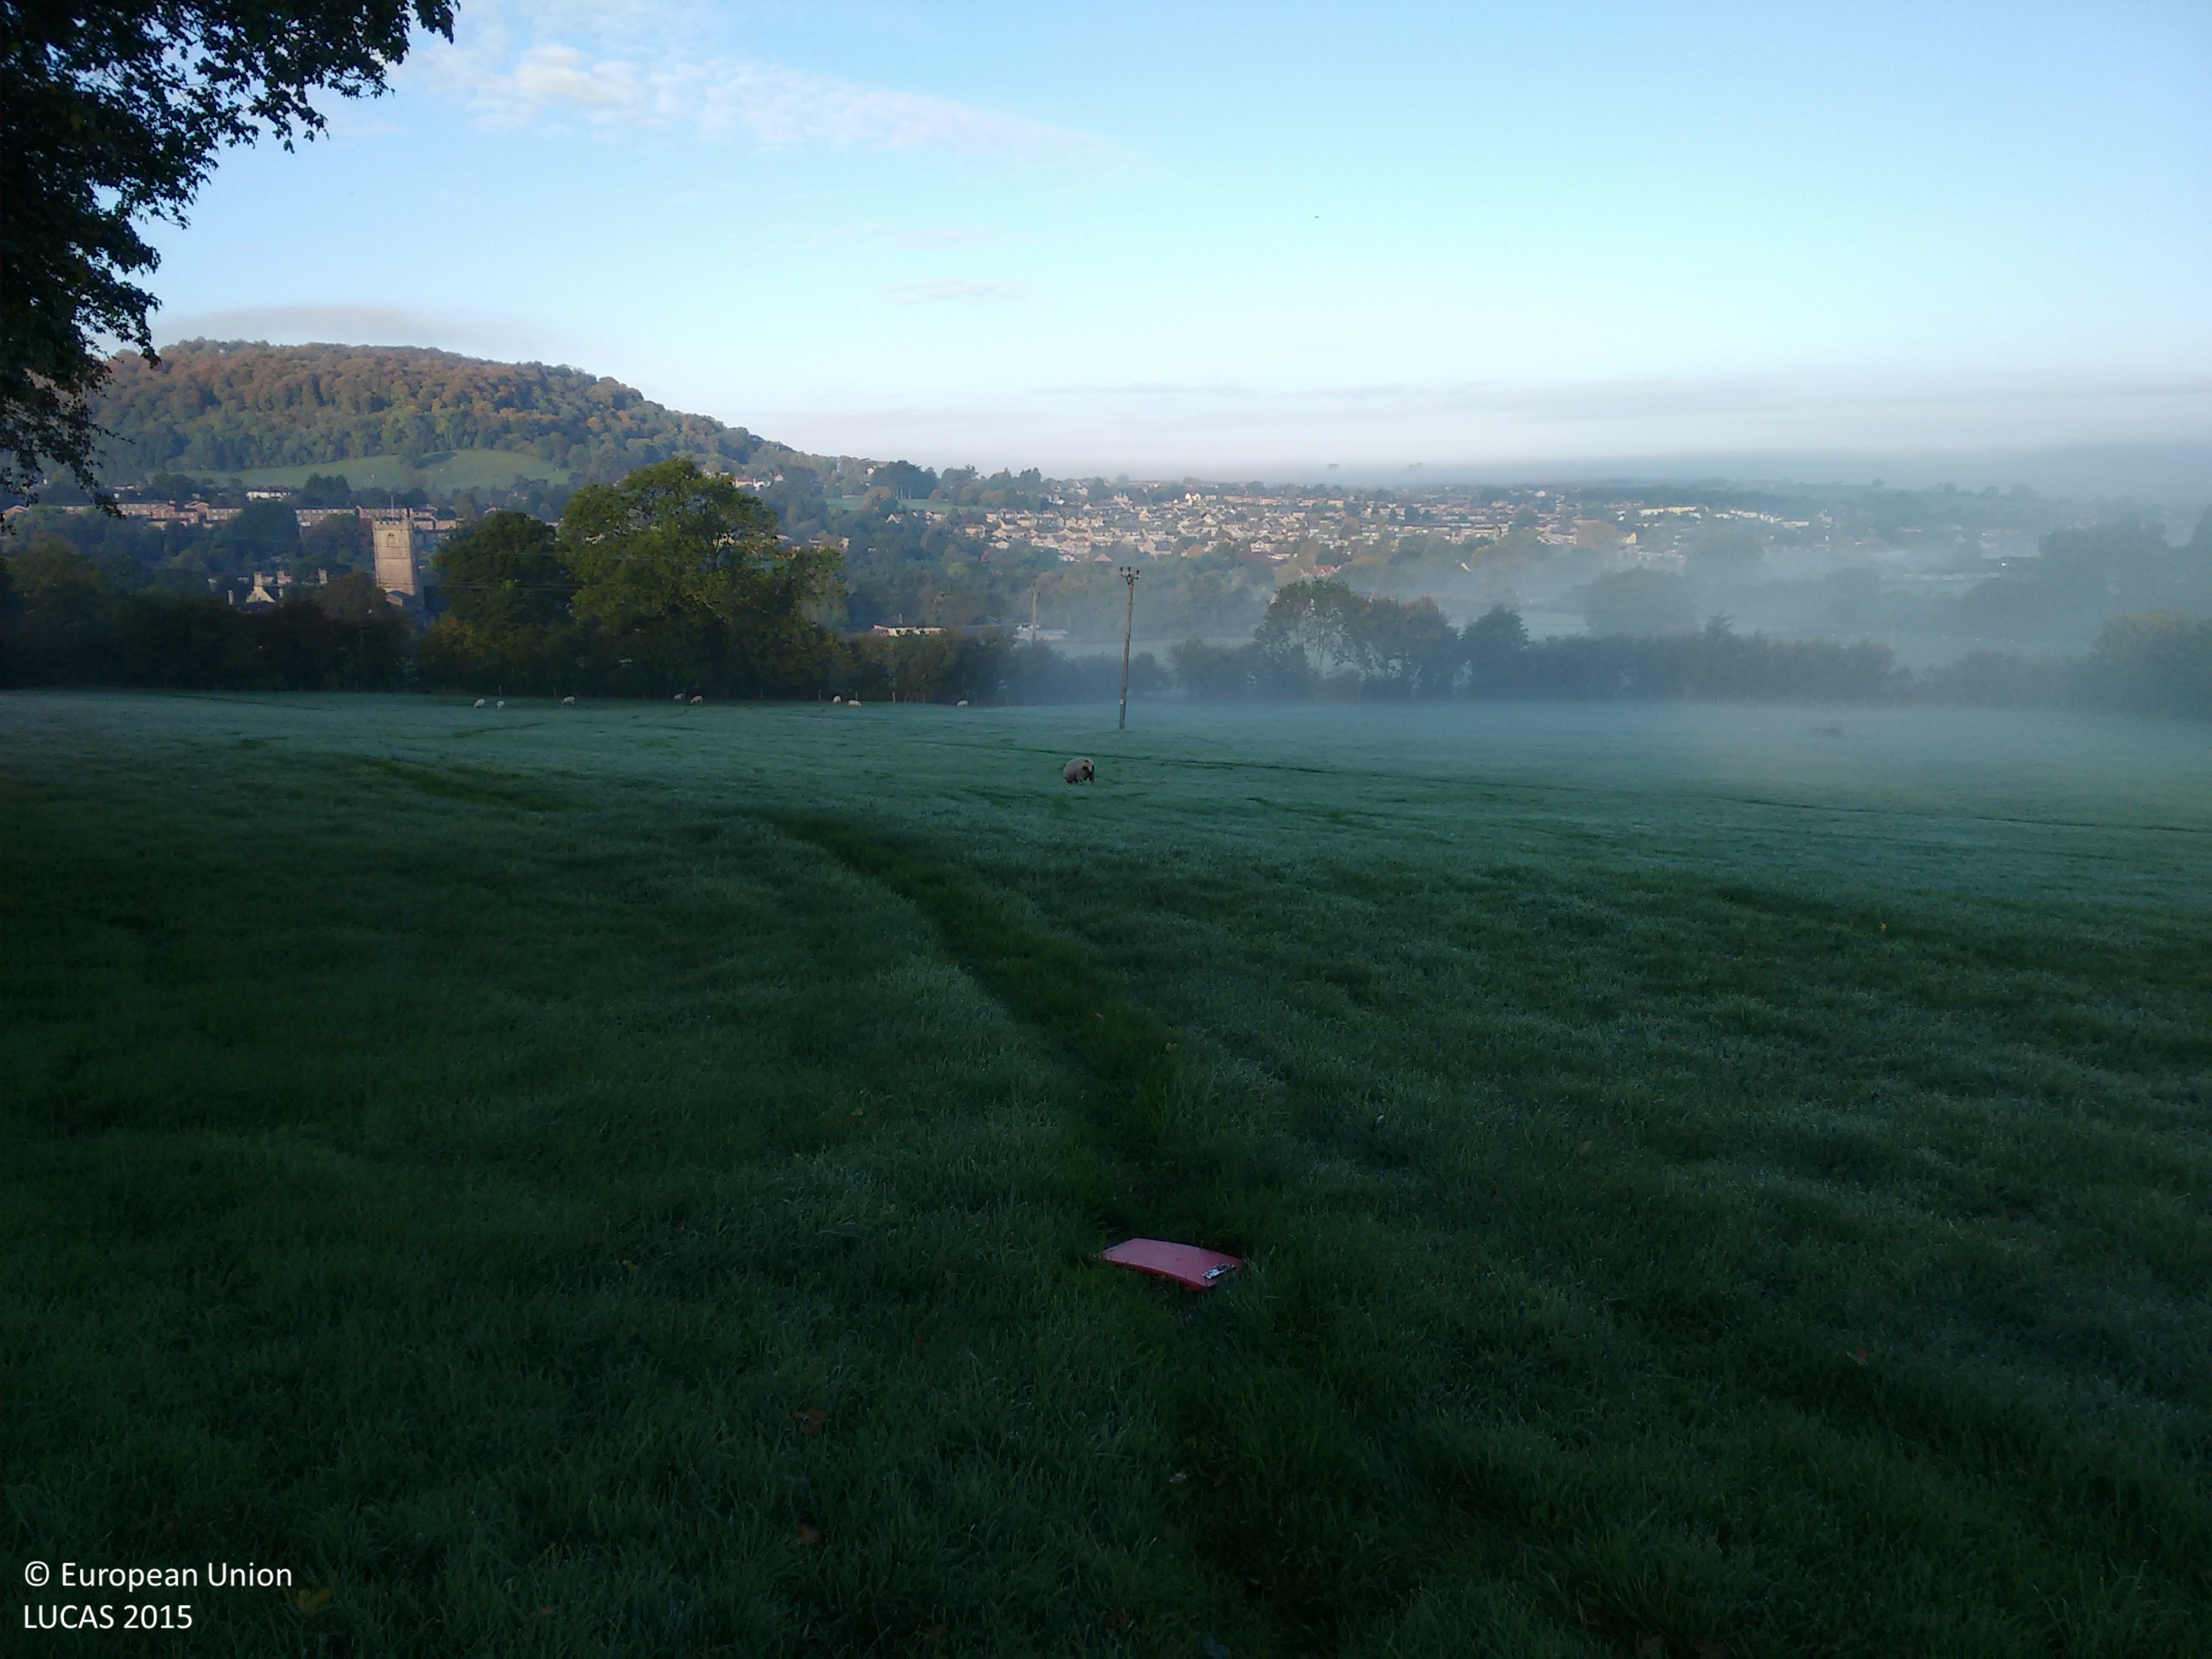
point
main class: Grassland
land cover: Grassland without tree/shrub cover
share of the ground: > 75 %
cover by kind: herbaceous plants 100 %
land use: Agriculture (excluding fallow land and kitchen gardens)
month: October
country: GB
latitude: 51.6935
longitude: -2.3464
